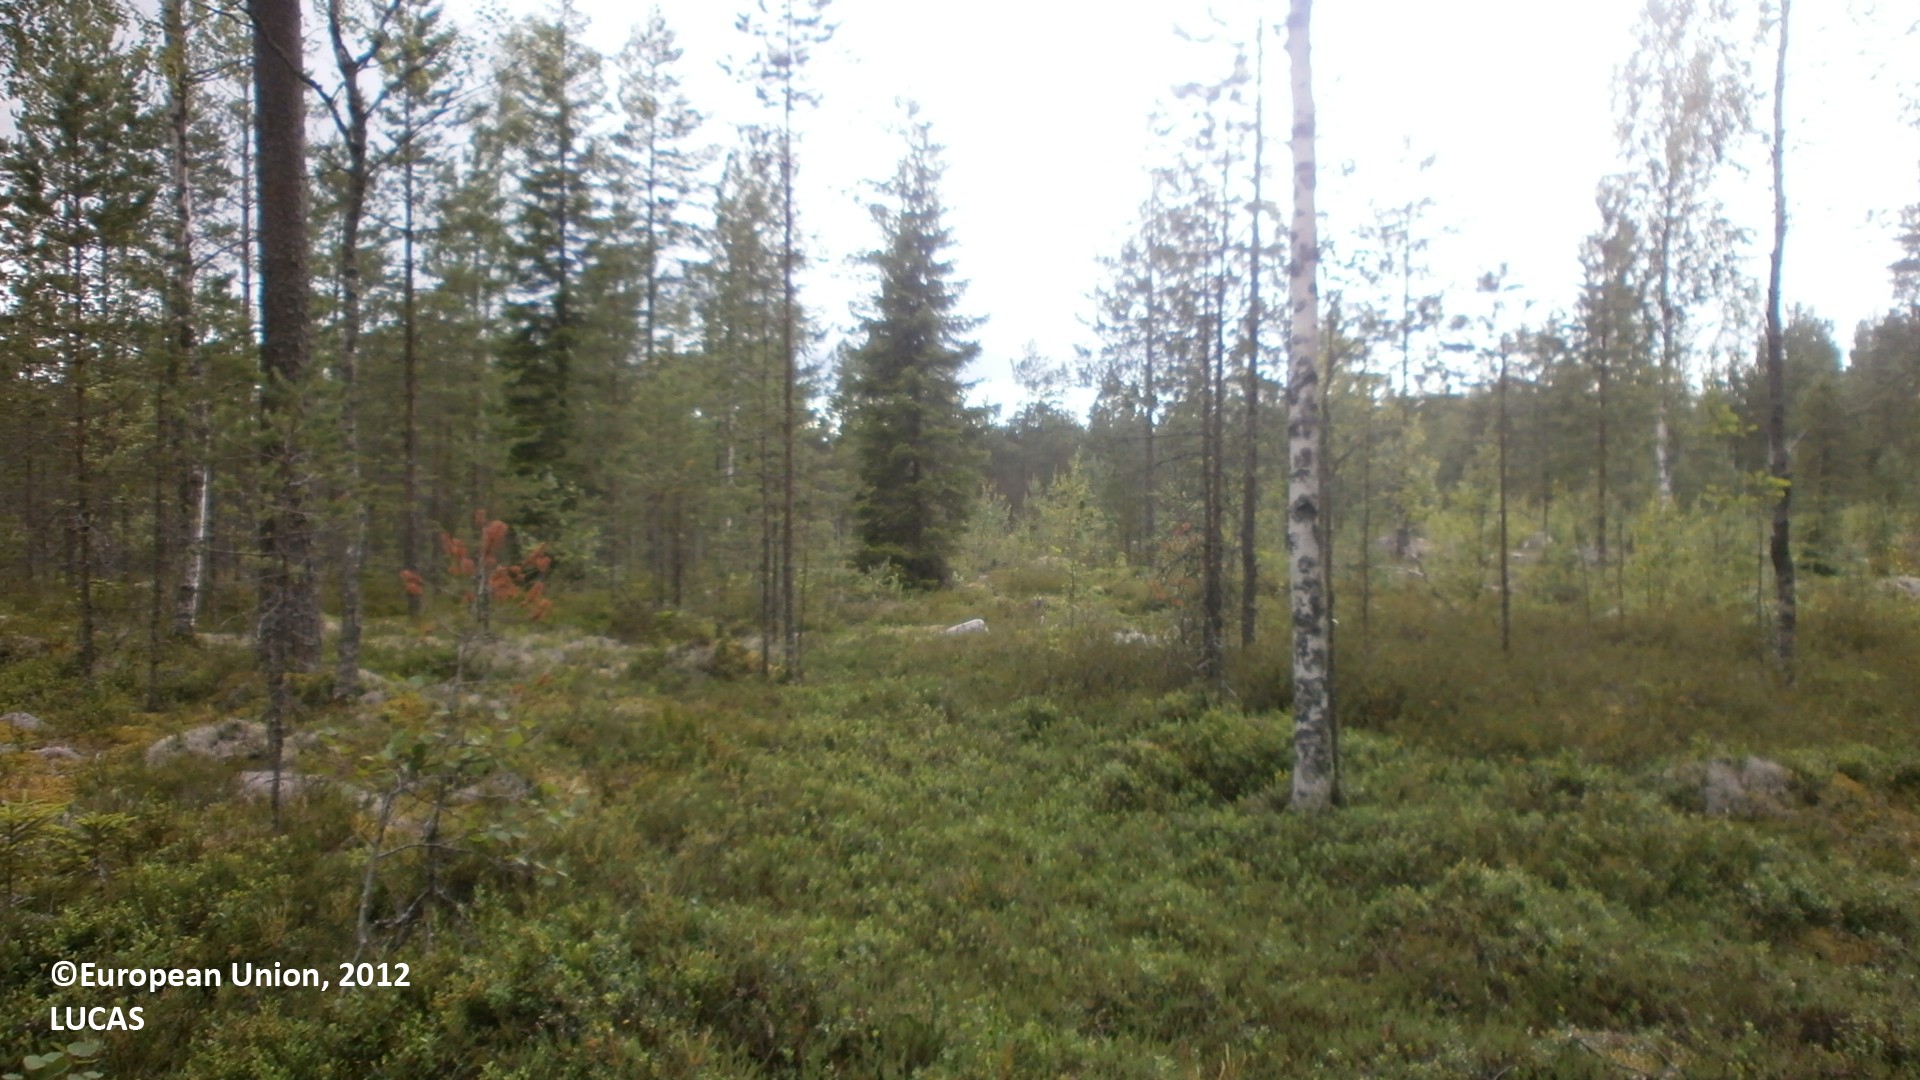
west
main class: Woodland
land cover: Pine dominated coniferous woodland
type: boreal forest
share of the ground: 50 - 75 %
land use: Forestry
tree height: > 5 m
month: July
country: FI
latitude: 63.9387
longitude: 24.2078
